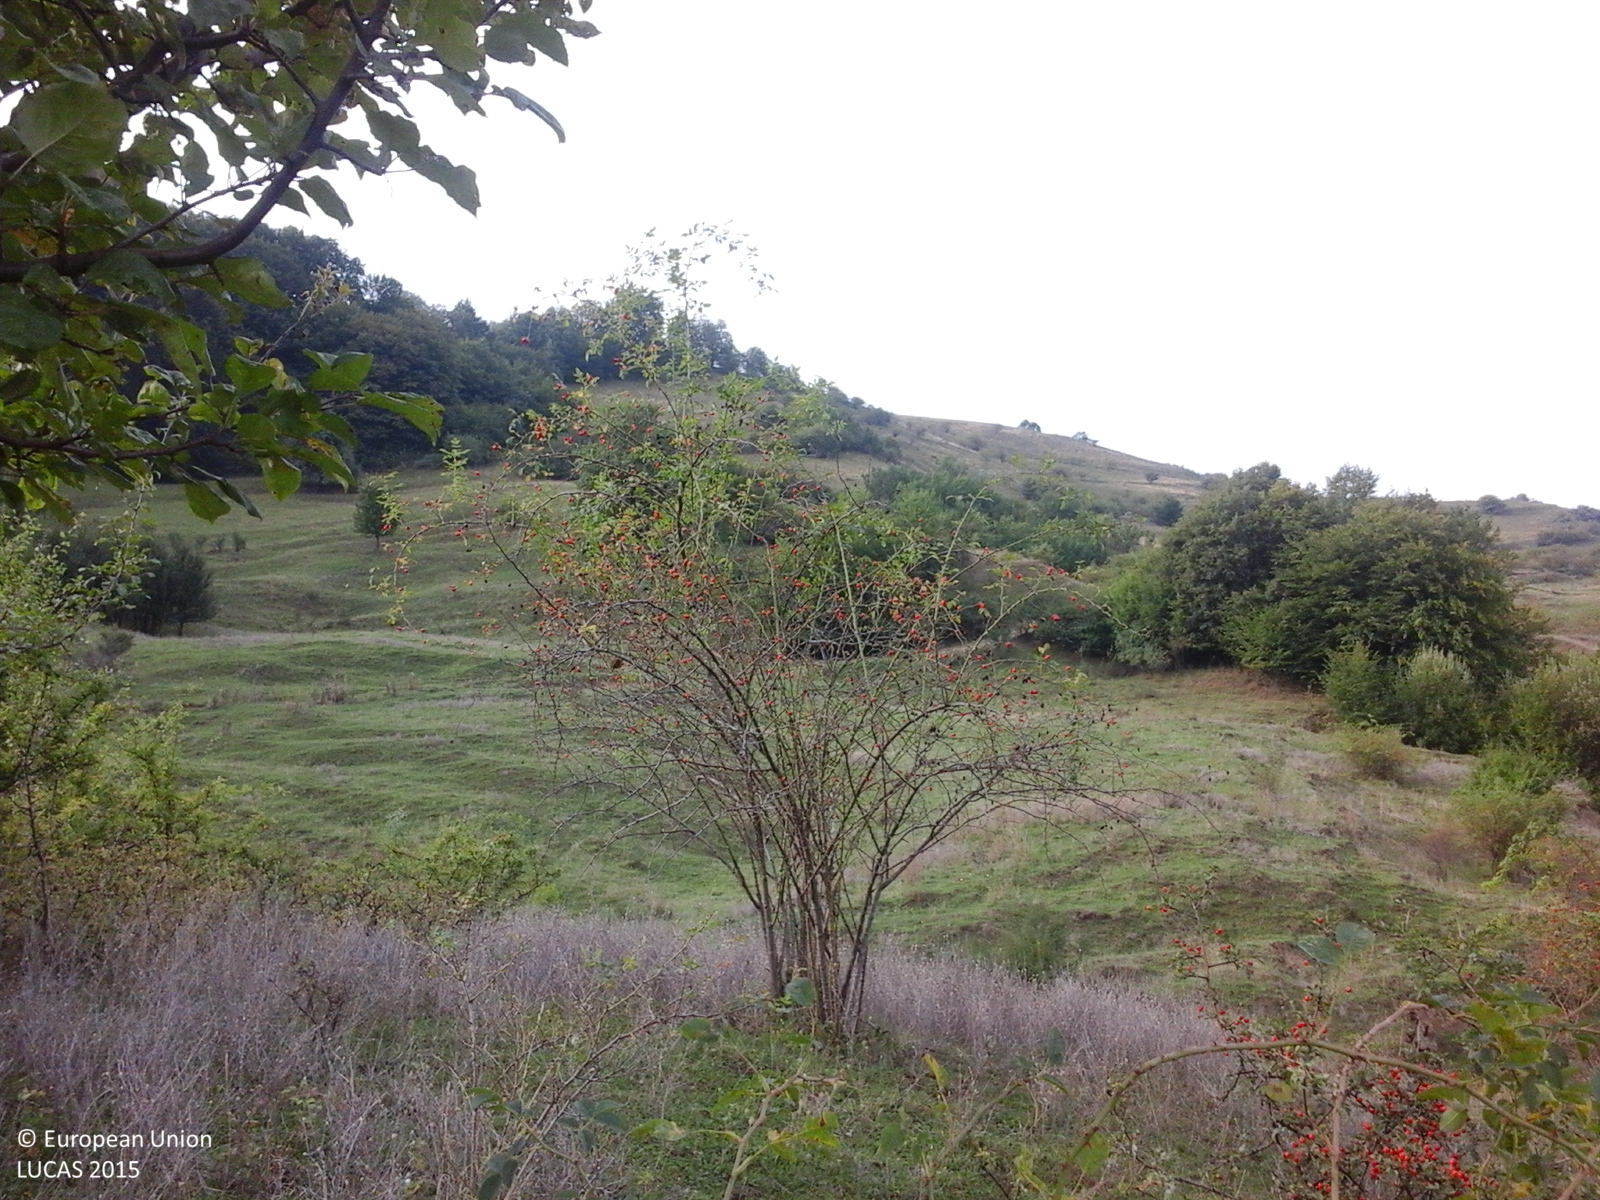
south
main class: Grassland
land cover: Grassland with sparse tree/shrub cover
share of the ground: > 75 %
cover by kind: herbaceous plants 90 %, broadleaved forest trees 5 %, shrubs 5 %
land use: Agriculture (excluding fallow land and kitchen gardens)
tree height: < 5 m
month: September
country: RO
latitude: 47.1774
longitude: 23.4371
